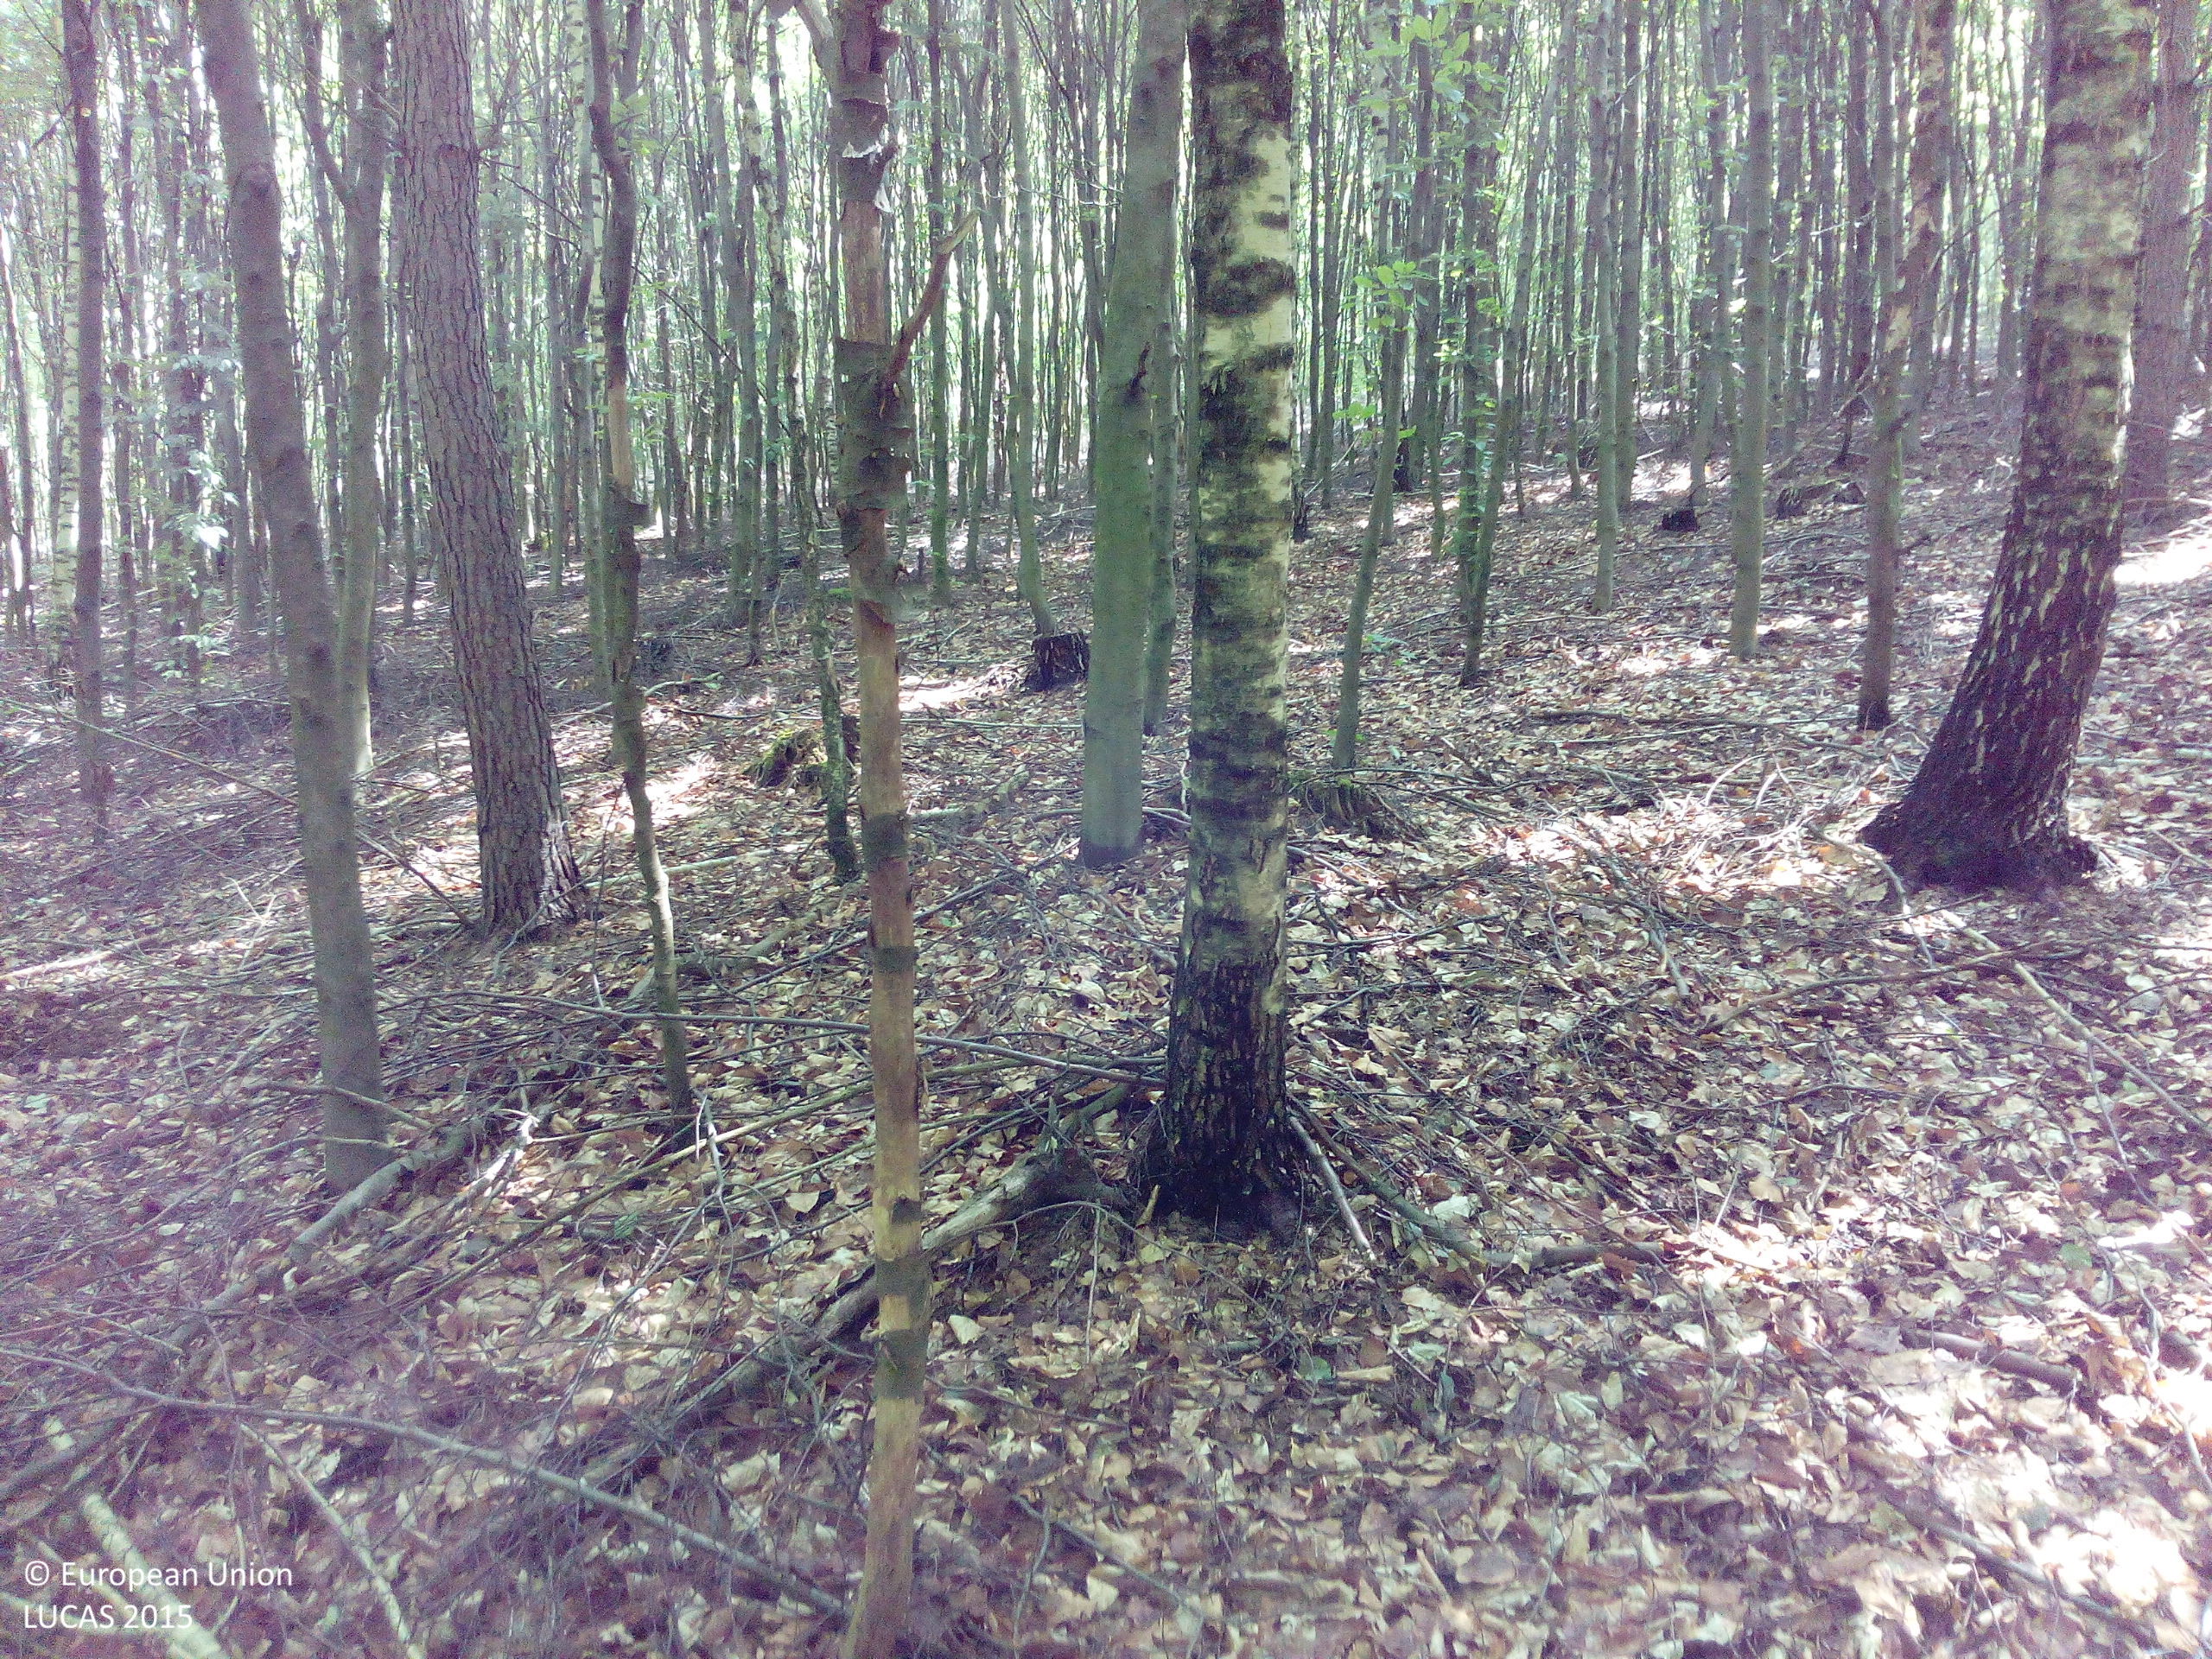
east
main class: Woodland
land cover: Broadleaved woodland
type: beech forest
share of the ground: > 75 %
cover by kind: broadleaved forest trees 90 %, coniferous forest trees 5 %, unconsolidated bare surface 5 %
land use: Forestry
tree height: > 5 m
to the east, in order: Broadleaved woodland; Tracks; Broadleaved woodland; Tracks; Spruce dominated coniferous woodland; Tracks; Spruce dominated coniferous woodland
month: June
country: DE
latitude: 51.0329
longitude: 13.9795
